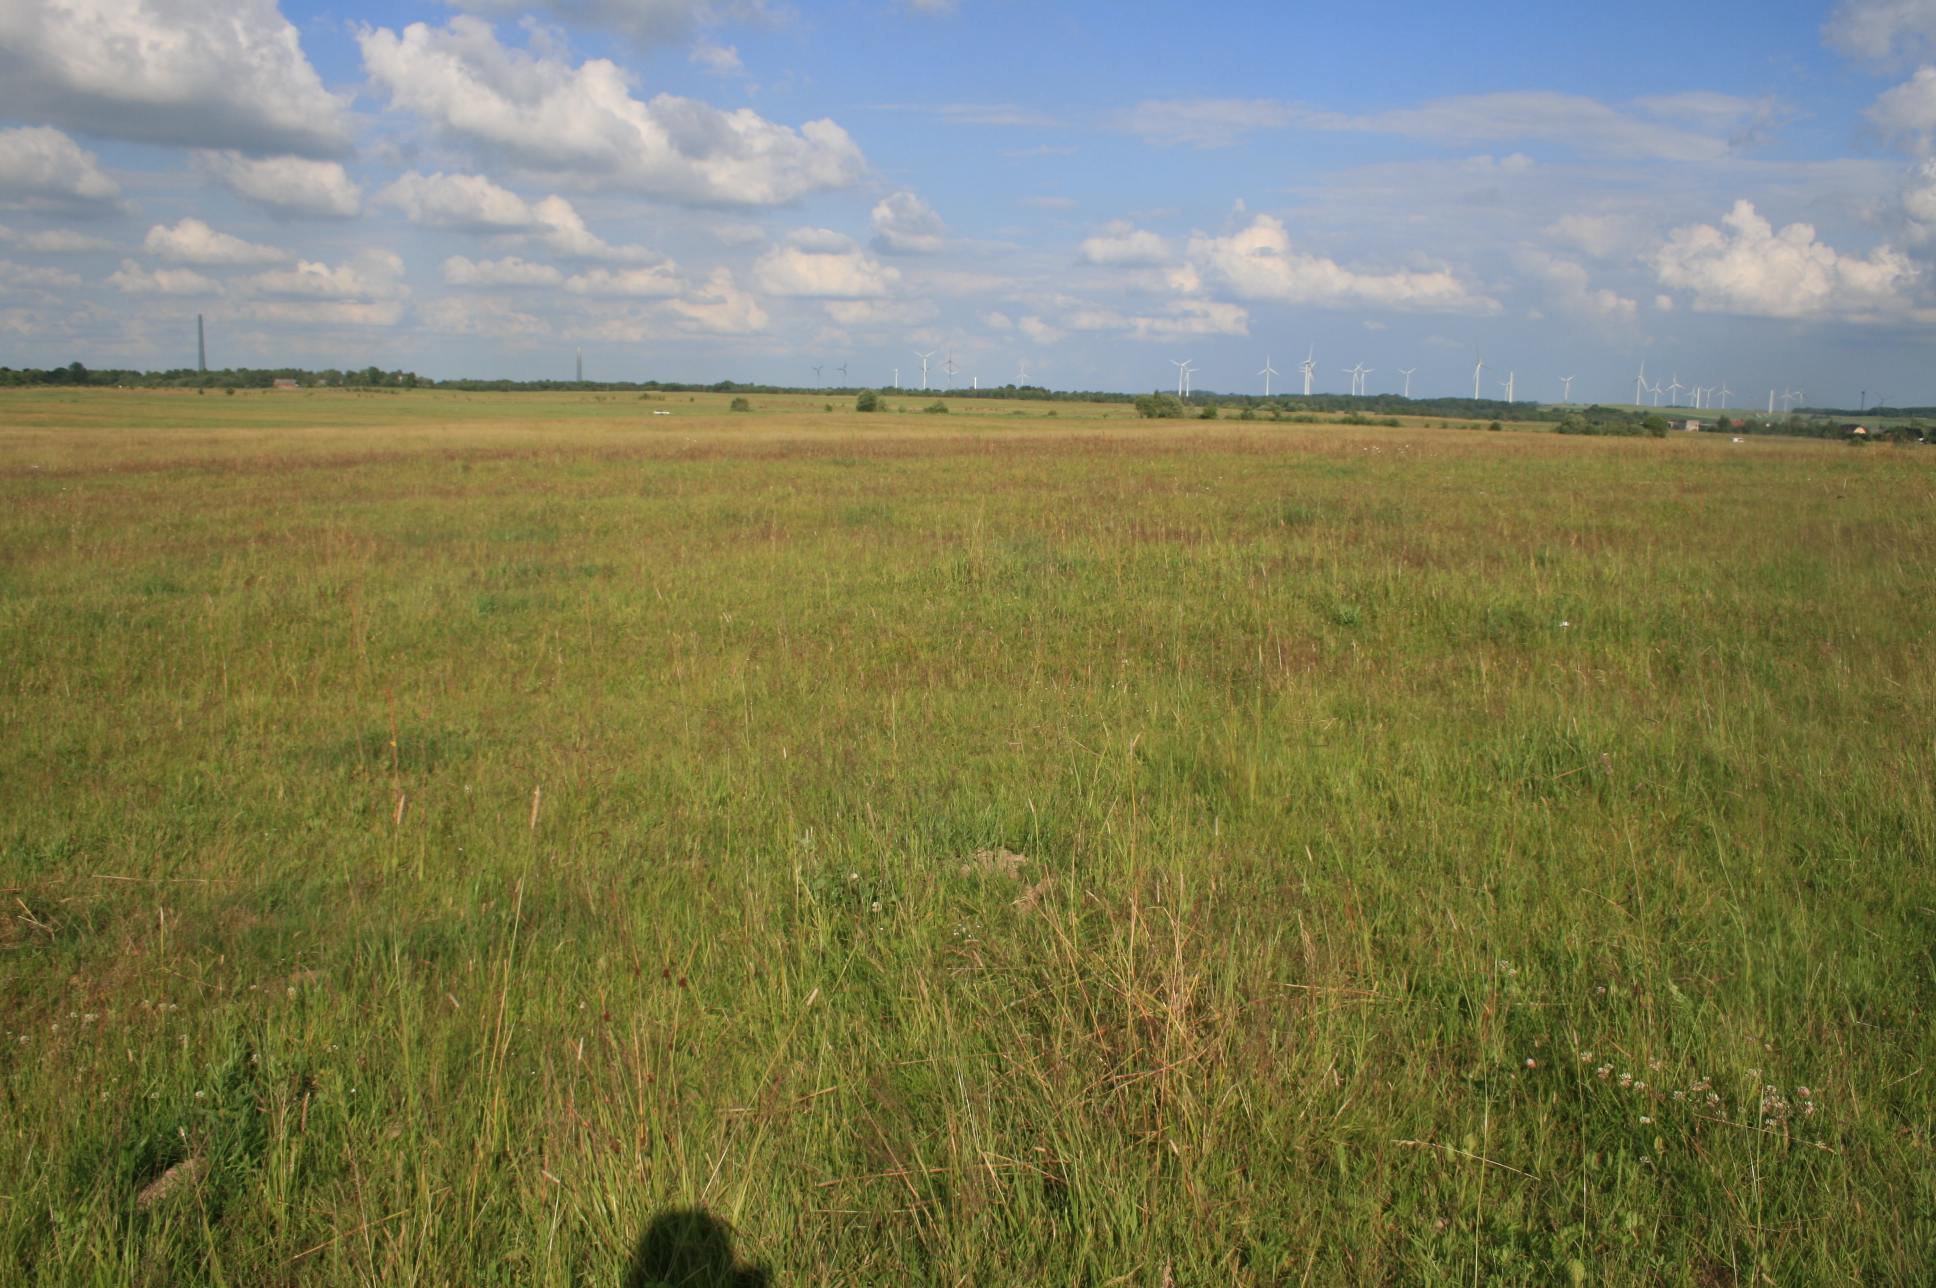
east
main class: Grassland
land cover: Grassland without tree/shrub cover
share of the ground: > 75 %
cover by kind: herbaceous plants 100 %
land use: Agriculture (excluding fallow land and kitchen gardens)
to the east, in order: Grassland without tree/shrub cover
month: June
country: LT
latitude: 55.2056
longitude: 21.9802
